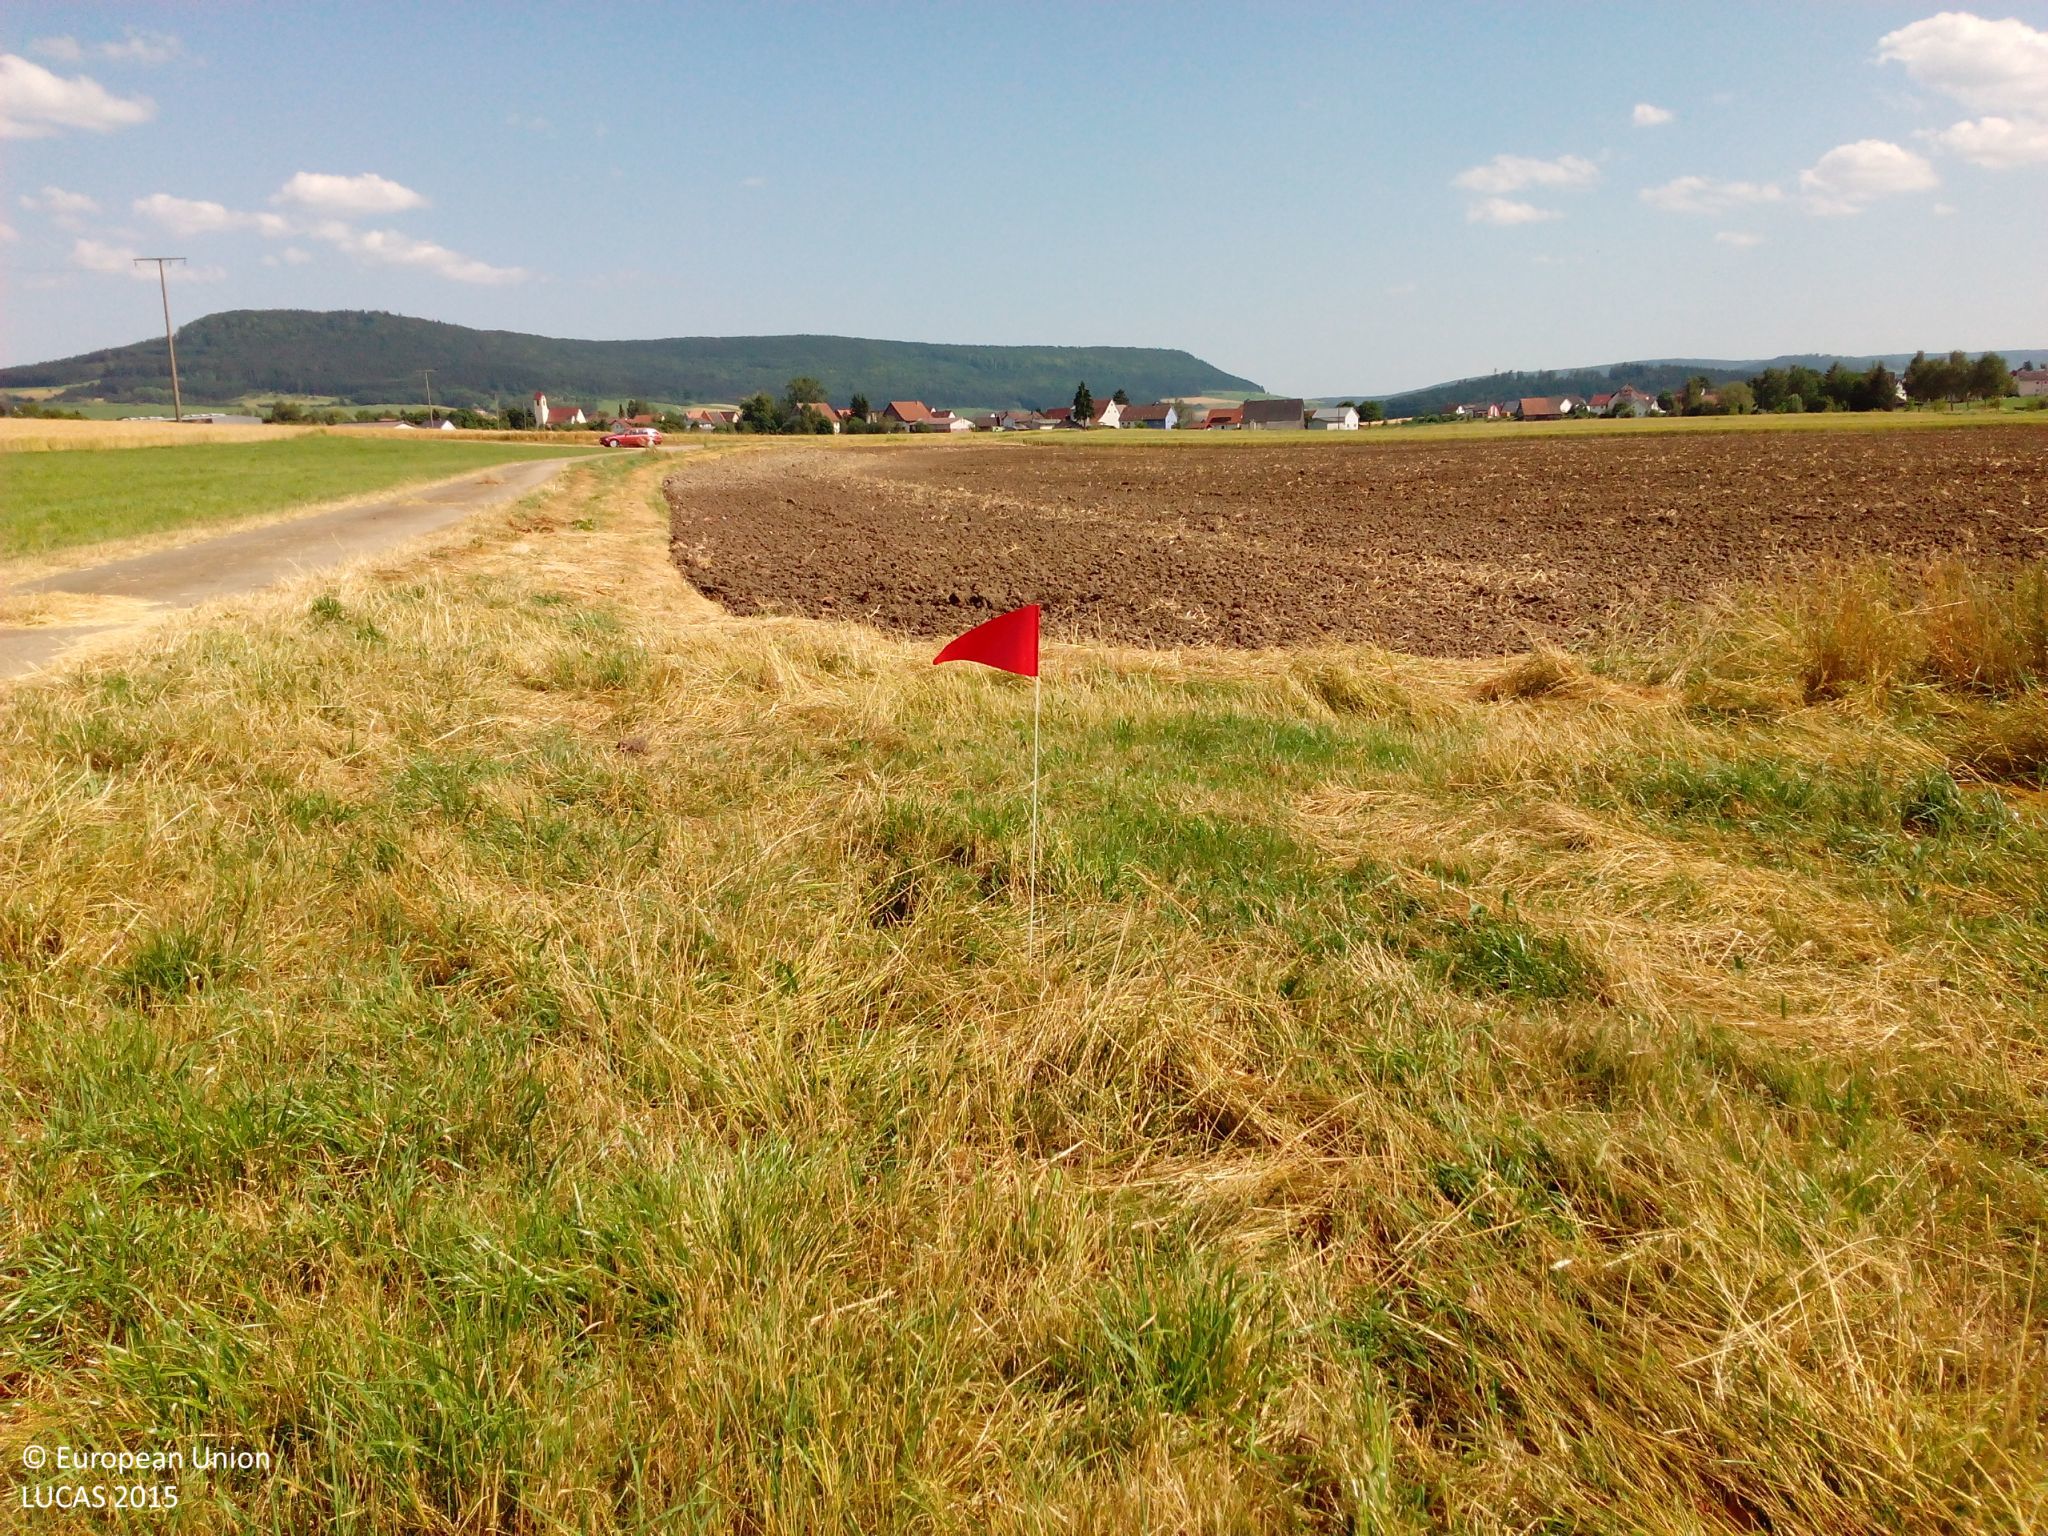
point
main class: Grassland
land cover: Grassland without tree/shrub cover
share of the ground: > 75 %
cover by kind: herbaceous plants 100 %
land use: Agriculture (excluding fallow land and kitchen gardens)
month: July
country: DE
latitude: 47.9806
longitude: 8.5942
